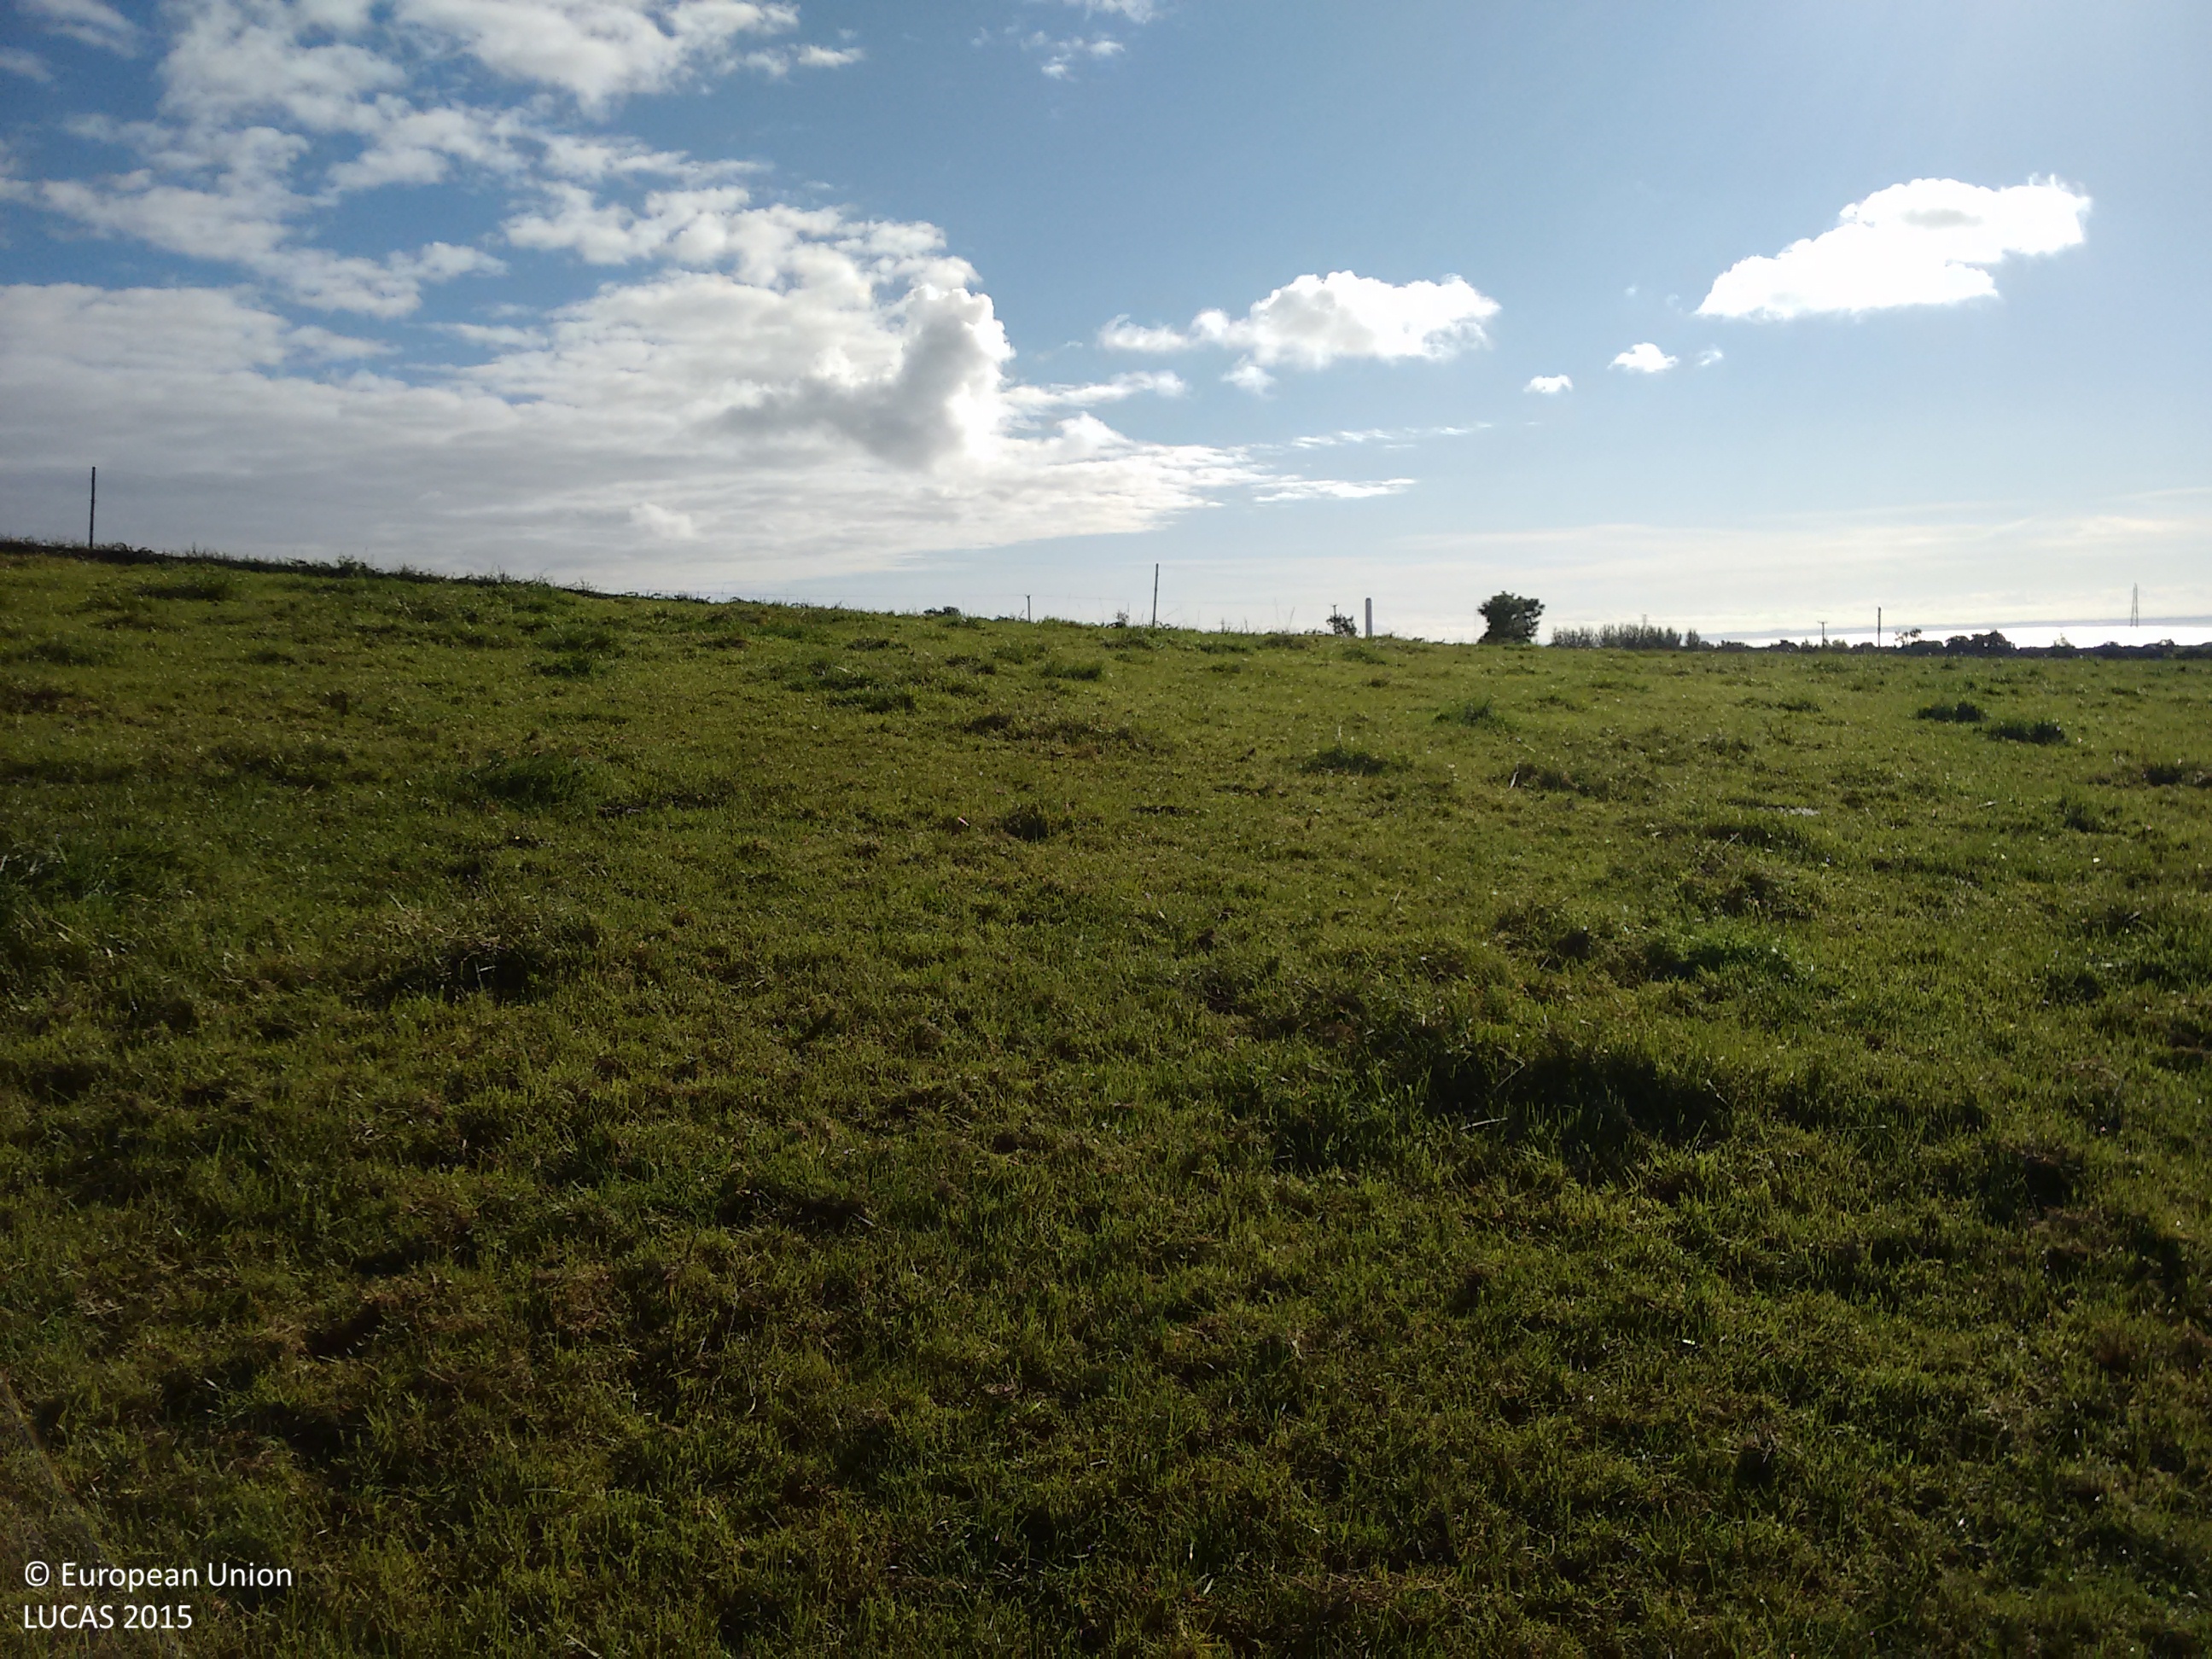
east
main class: Grassland
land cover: Grassland without tree/shrub cover
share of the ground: > 75 %
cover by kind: herbaceous plants 100 %
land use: Agriculture (excluding fallow land and kitchen gardens)
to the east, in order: Grassland without tree/shrub cover; Ditches and canals; Managed hedges; Grass margins; Paved roads, cycling and walking lanes; Grass margins; Electric lines; Fences; Grassland without tree/shrub cover; Fences; Grass margins; Ditches and canals; Grassland without tree/shrub cover
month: September
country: GB
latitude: 54.7357
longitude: -5.8376
